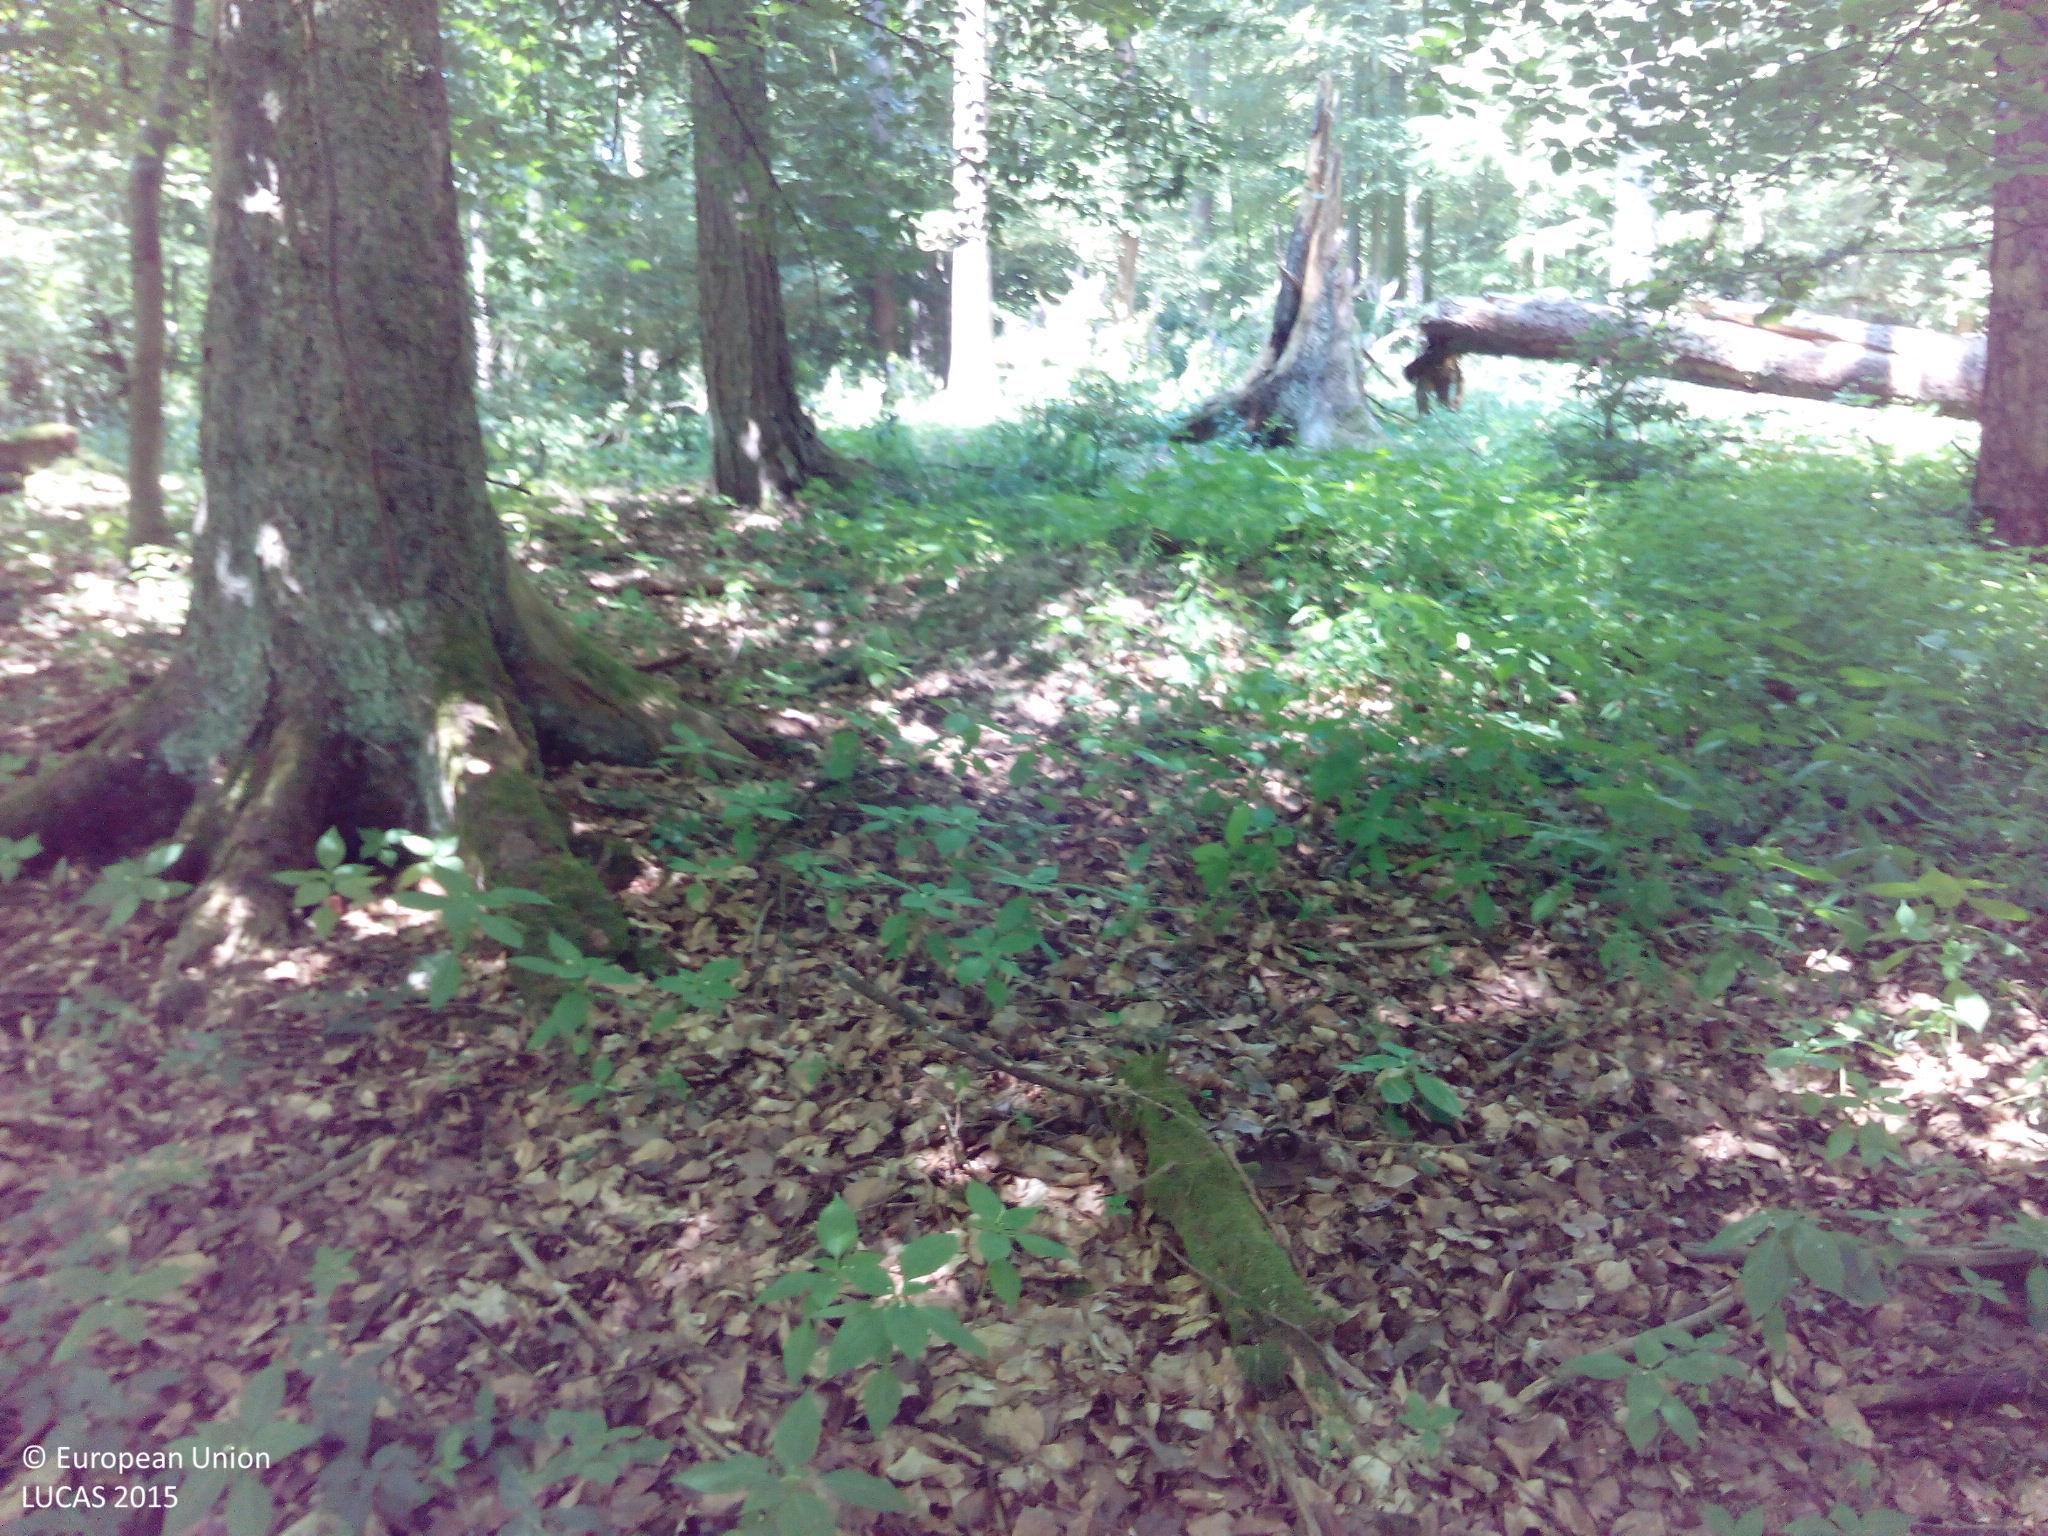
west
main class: Woodland
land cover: Spruce dominated mixed woodland
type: mesophytic deciduous forest
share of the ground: > 75 %
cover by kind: broadleaved forest trees 55 %, coniferous forest trees 30 %, herbaceous plants 10 %, unconsolidated bare surface 5 %
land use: Forestry
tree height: > 5 m
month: July
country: DE
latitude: 50.1133
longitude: 8.0286
